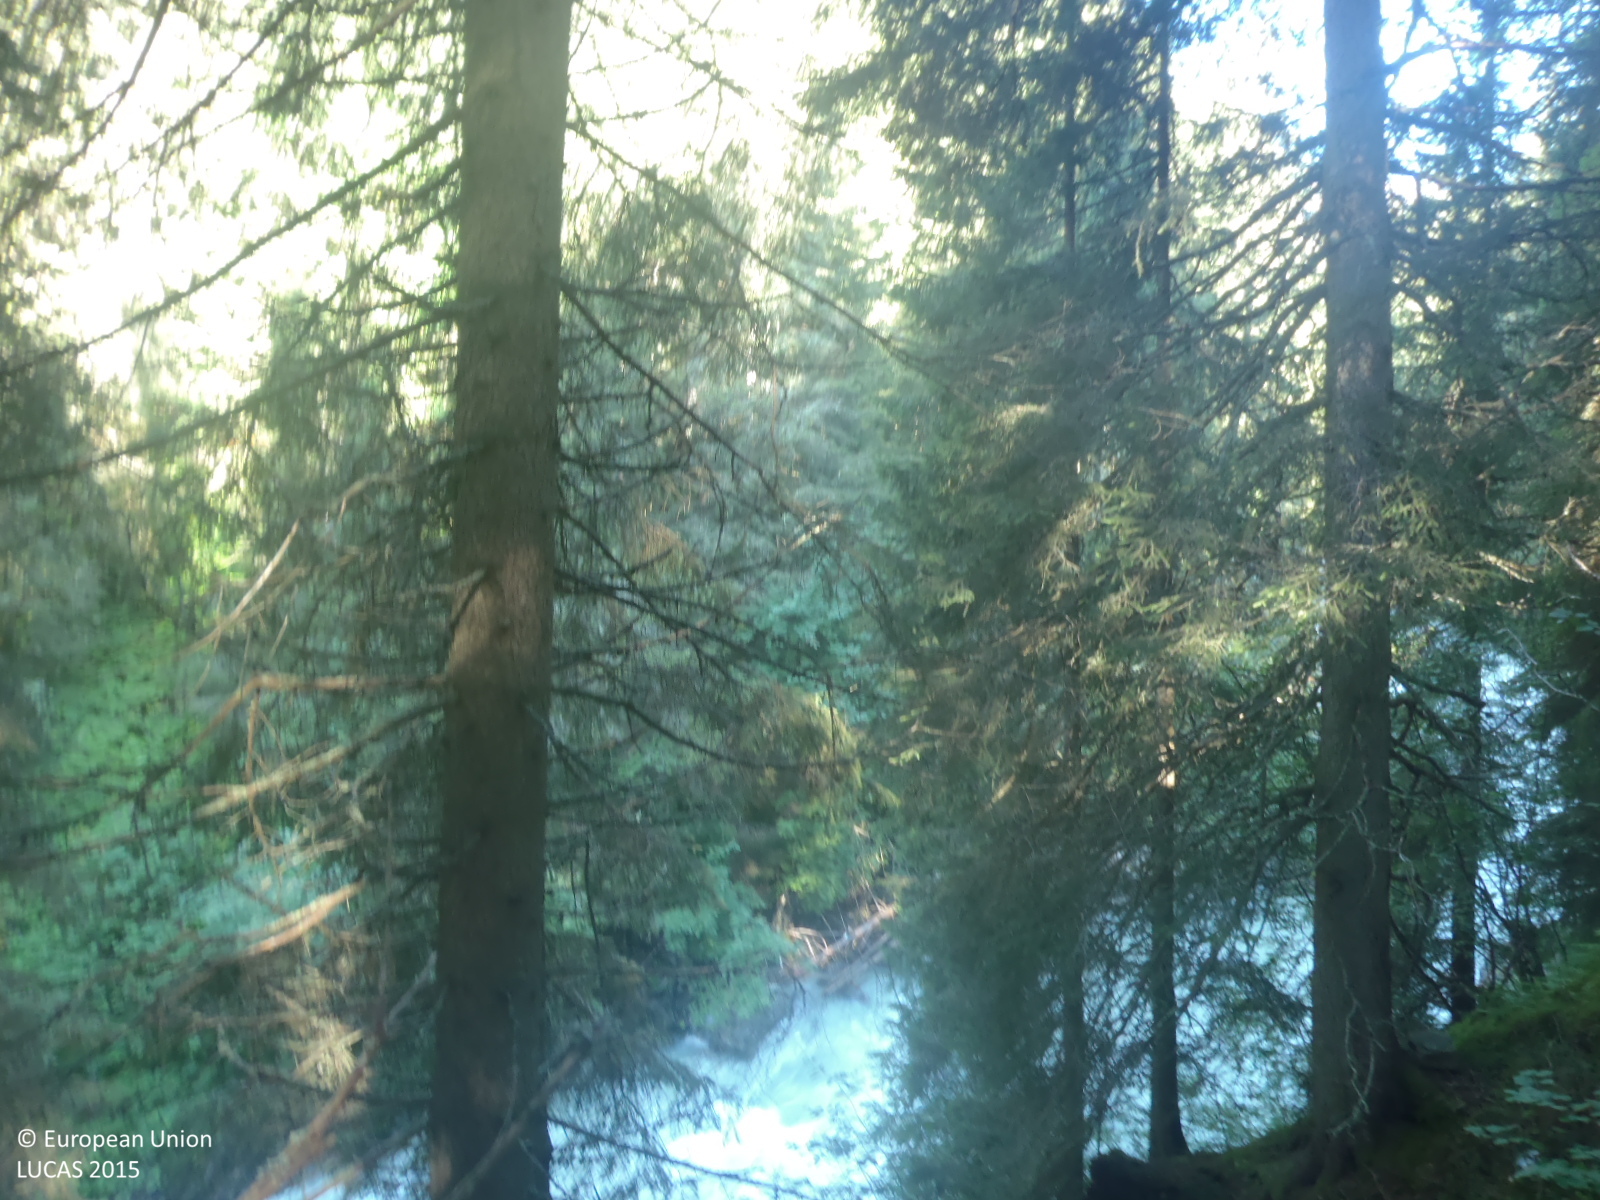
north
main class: Woodland
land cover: Spruce dominated coniferous woodland
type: alpine coniferous forest
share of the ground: > 75 %
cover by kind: coniferous forest trees 95 %, broadleaved forest trees 5 %
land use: Forestry
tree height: > 5 m
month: August
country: AT
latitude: 47.0964
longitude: 12.5143
